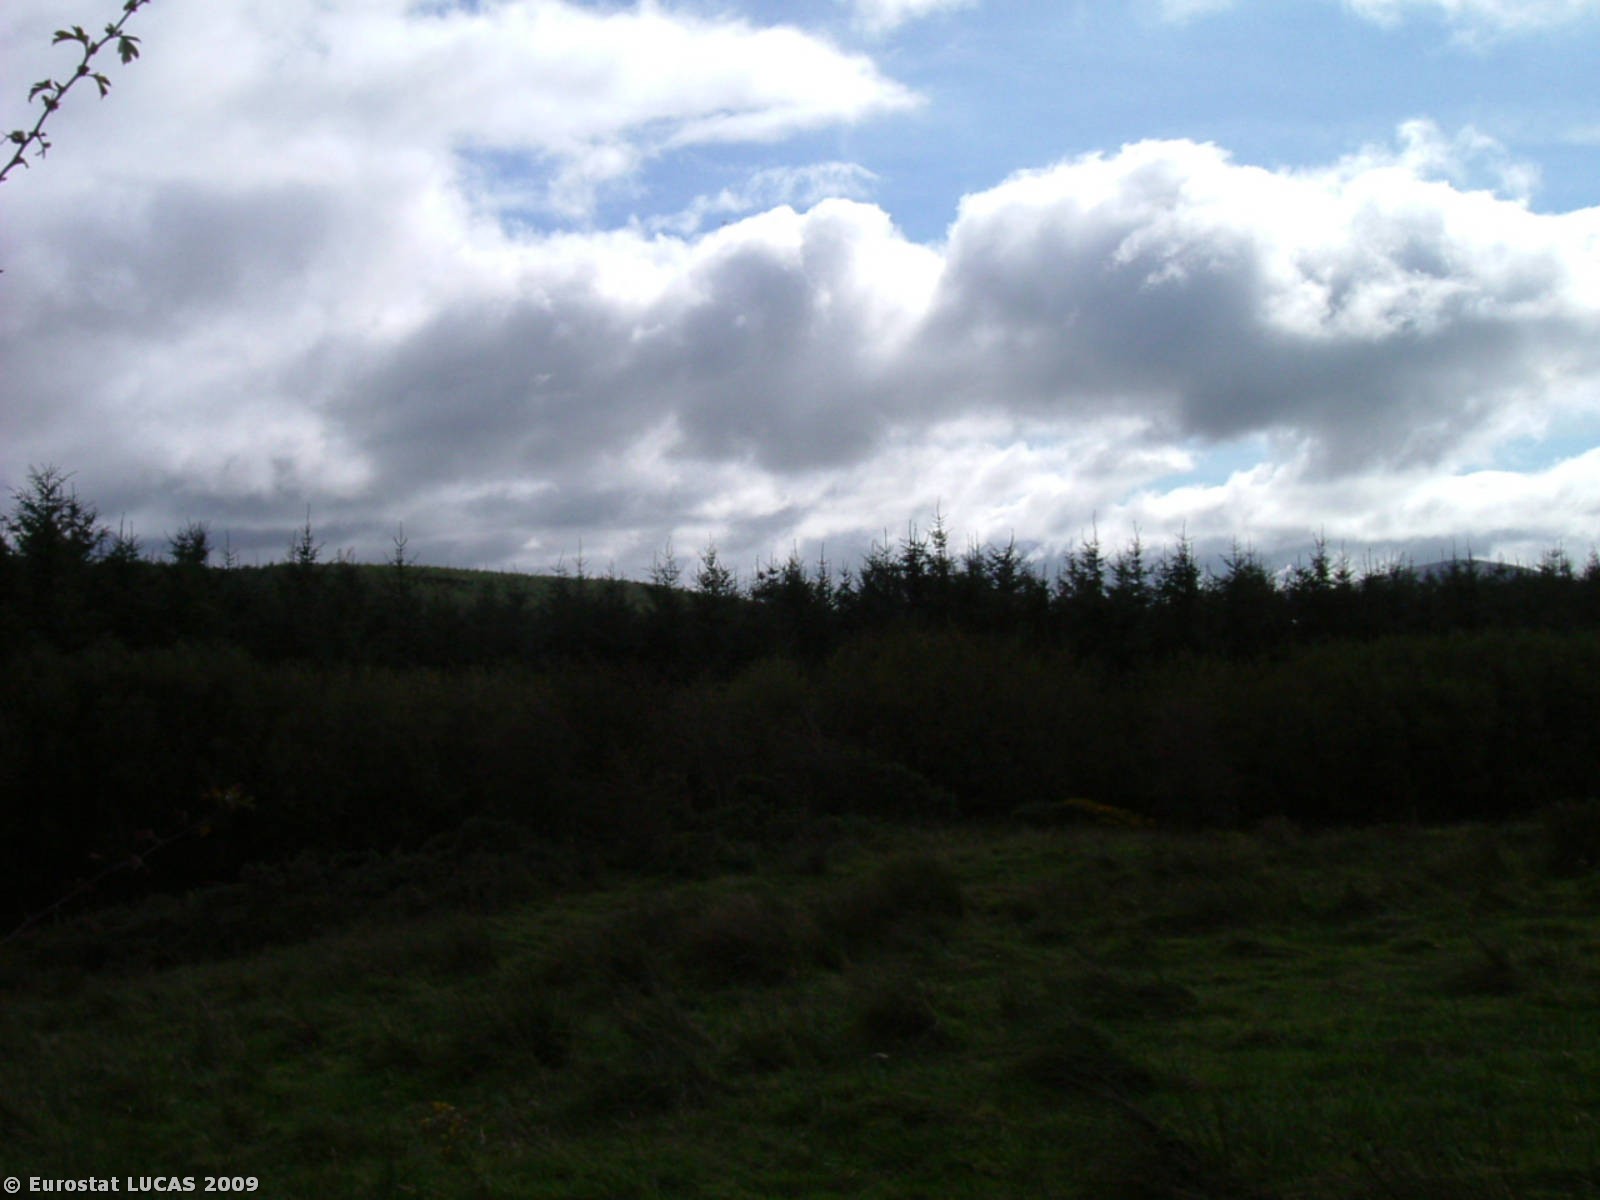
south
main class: Grassland
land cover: Grassland without tree/shrub cover
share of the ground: > 75 %
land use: Agriculture (excluding fallow land and kitchen gardens)
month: September
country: IE
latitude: 52.7637
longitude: -8.1885
